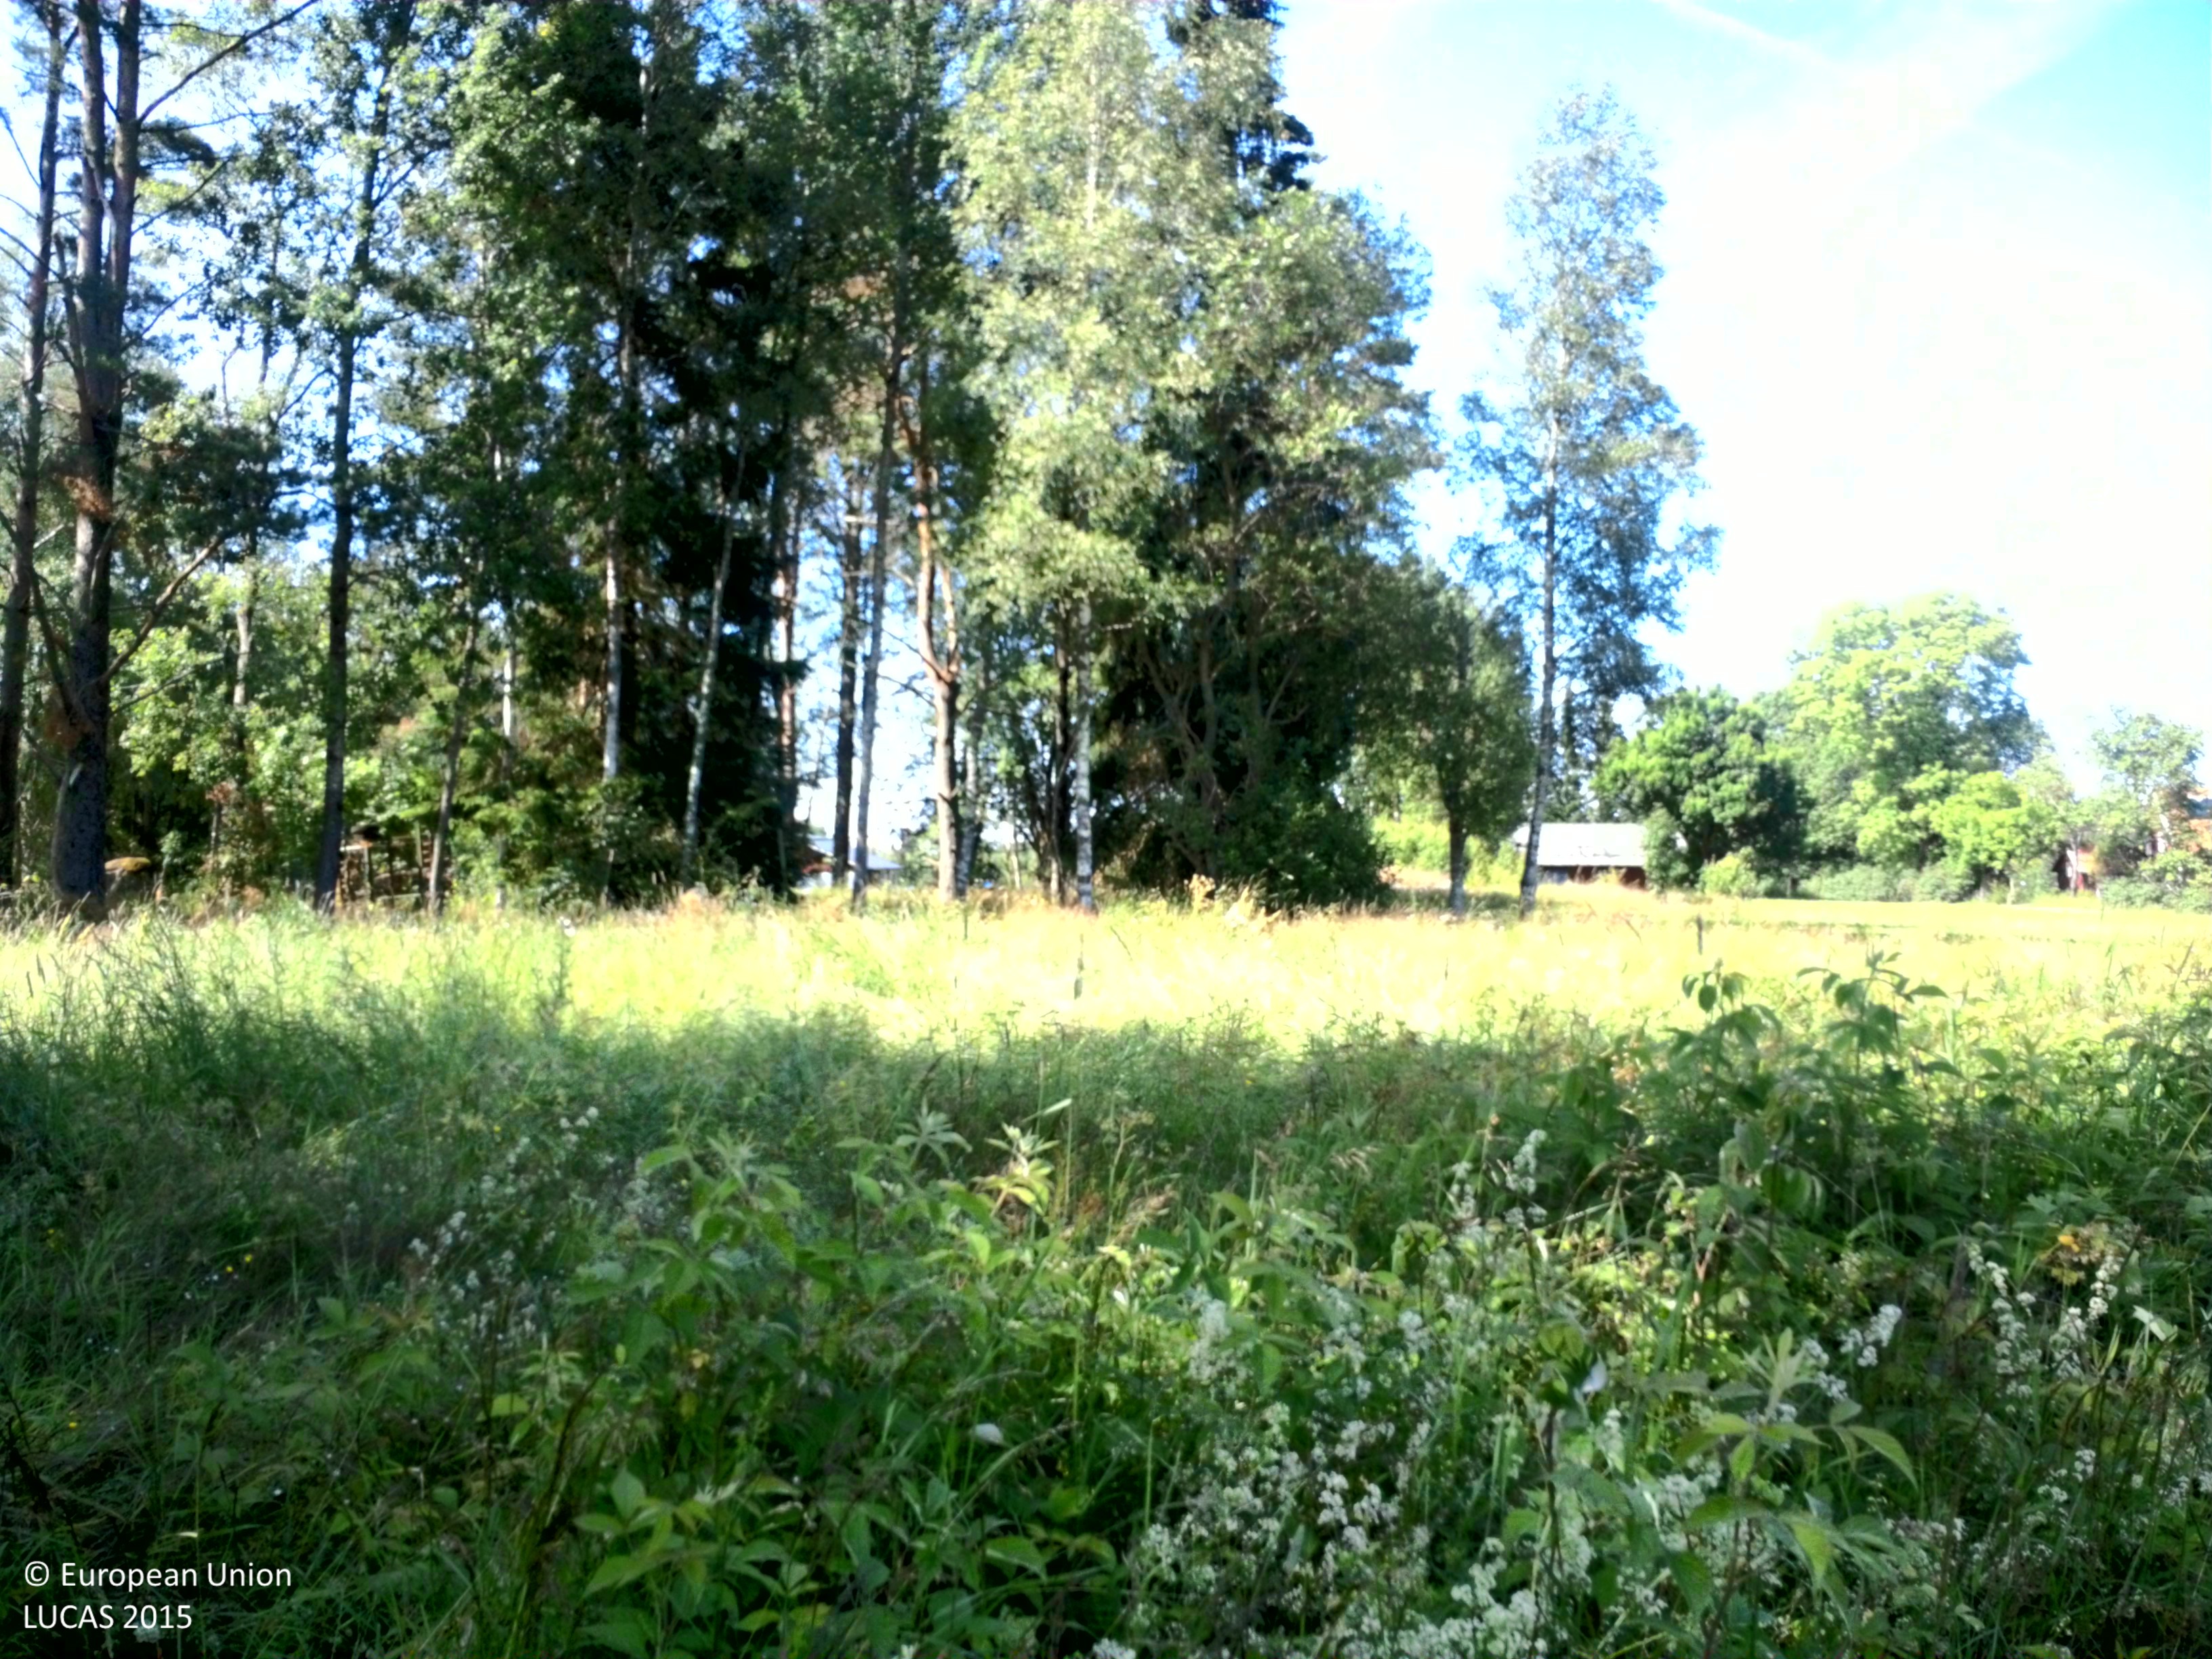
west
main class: Grassland
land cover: Grassland with sparse tree/shrub cover
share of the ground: > 75 %
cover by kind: herbaceous plants 90 %, broadleaved forest trees 5 %, shrubs 5 %
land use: Agriculture (excluding fallow land and kitchen gardens)
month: July
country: SE
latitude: 57.6274
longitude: 14.3324
